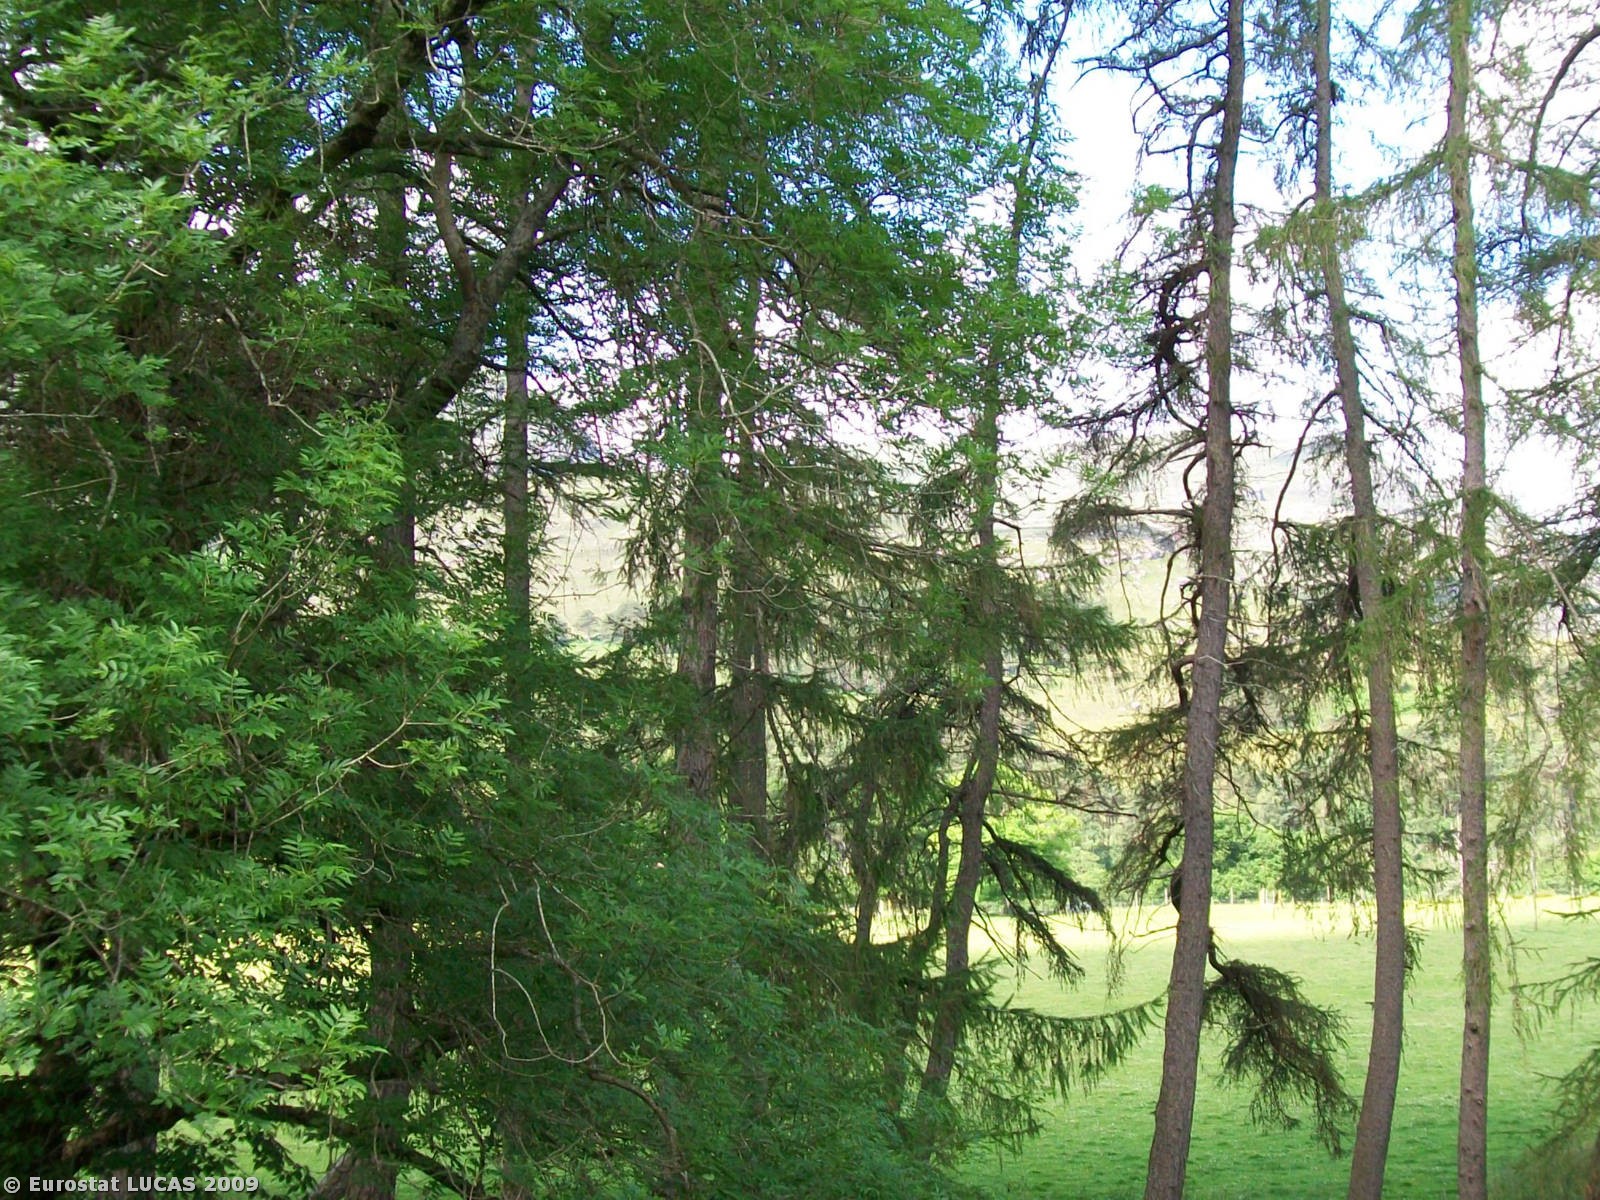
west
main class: Grassland
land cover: Grassland with sparse tree/shrub cover
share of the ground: > 75 %
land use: Forestry
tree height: > 5 m
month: July
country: GB
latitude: 57.8275
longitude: -5.1753
